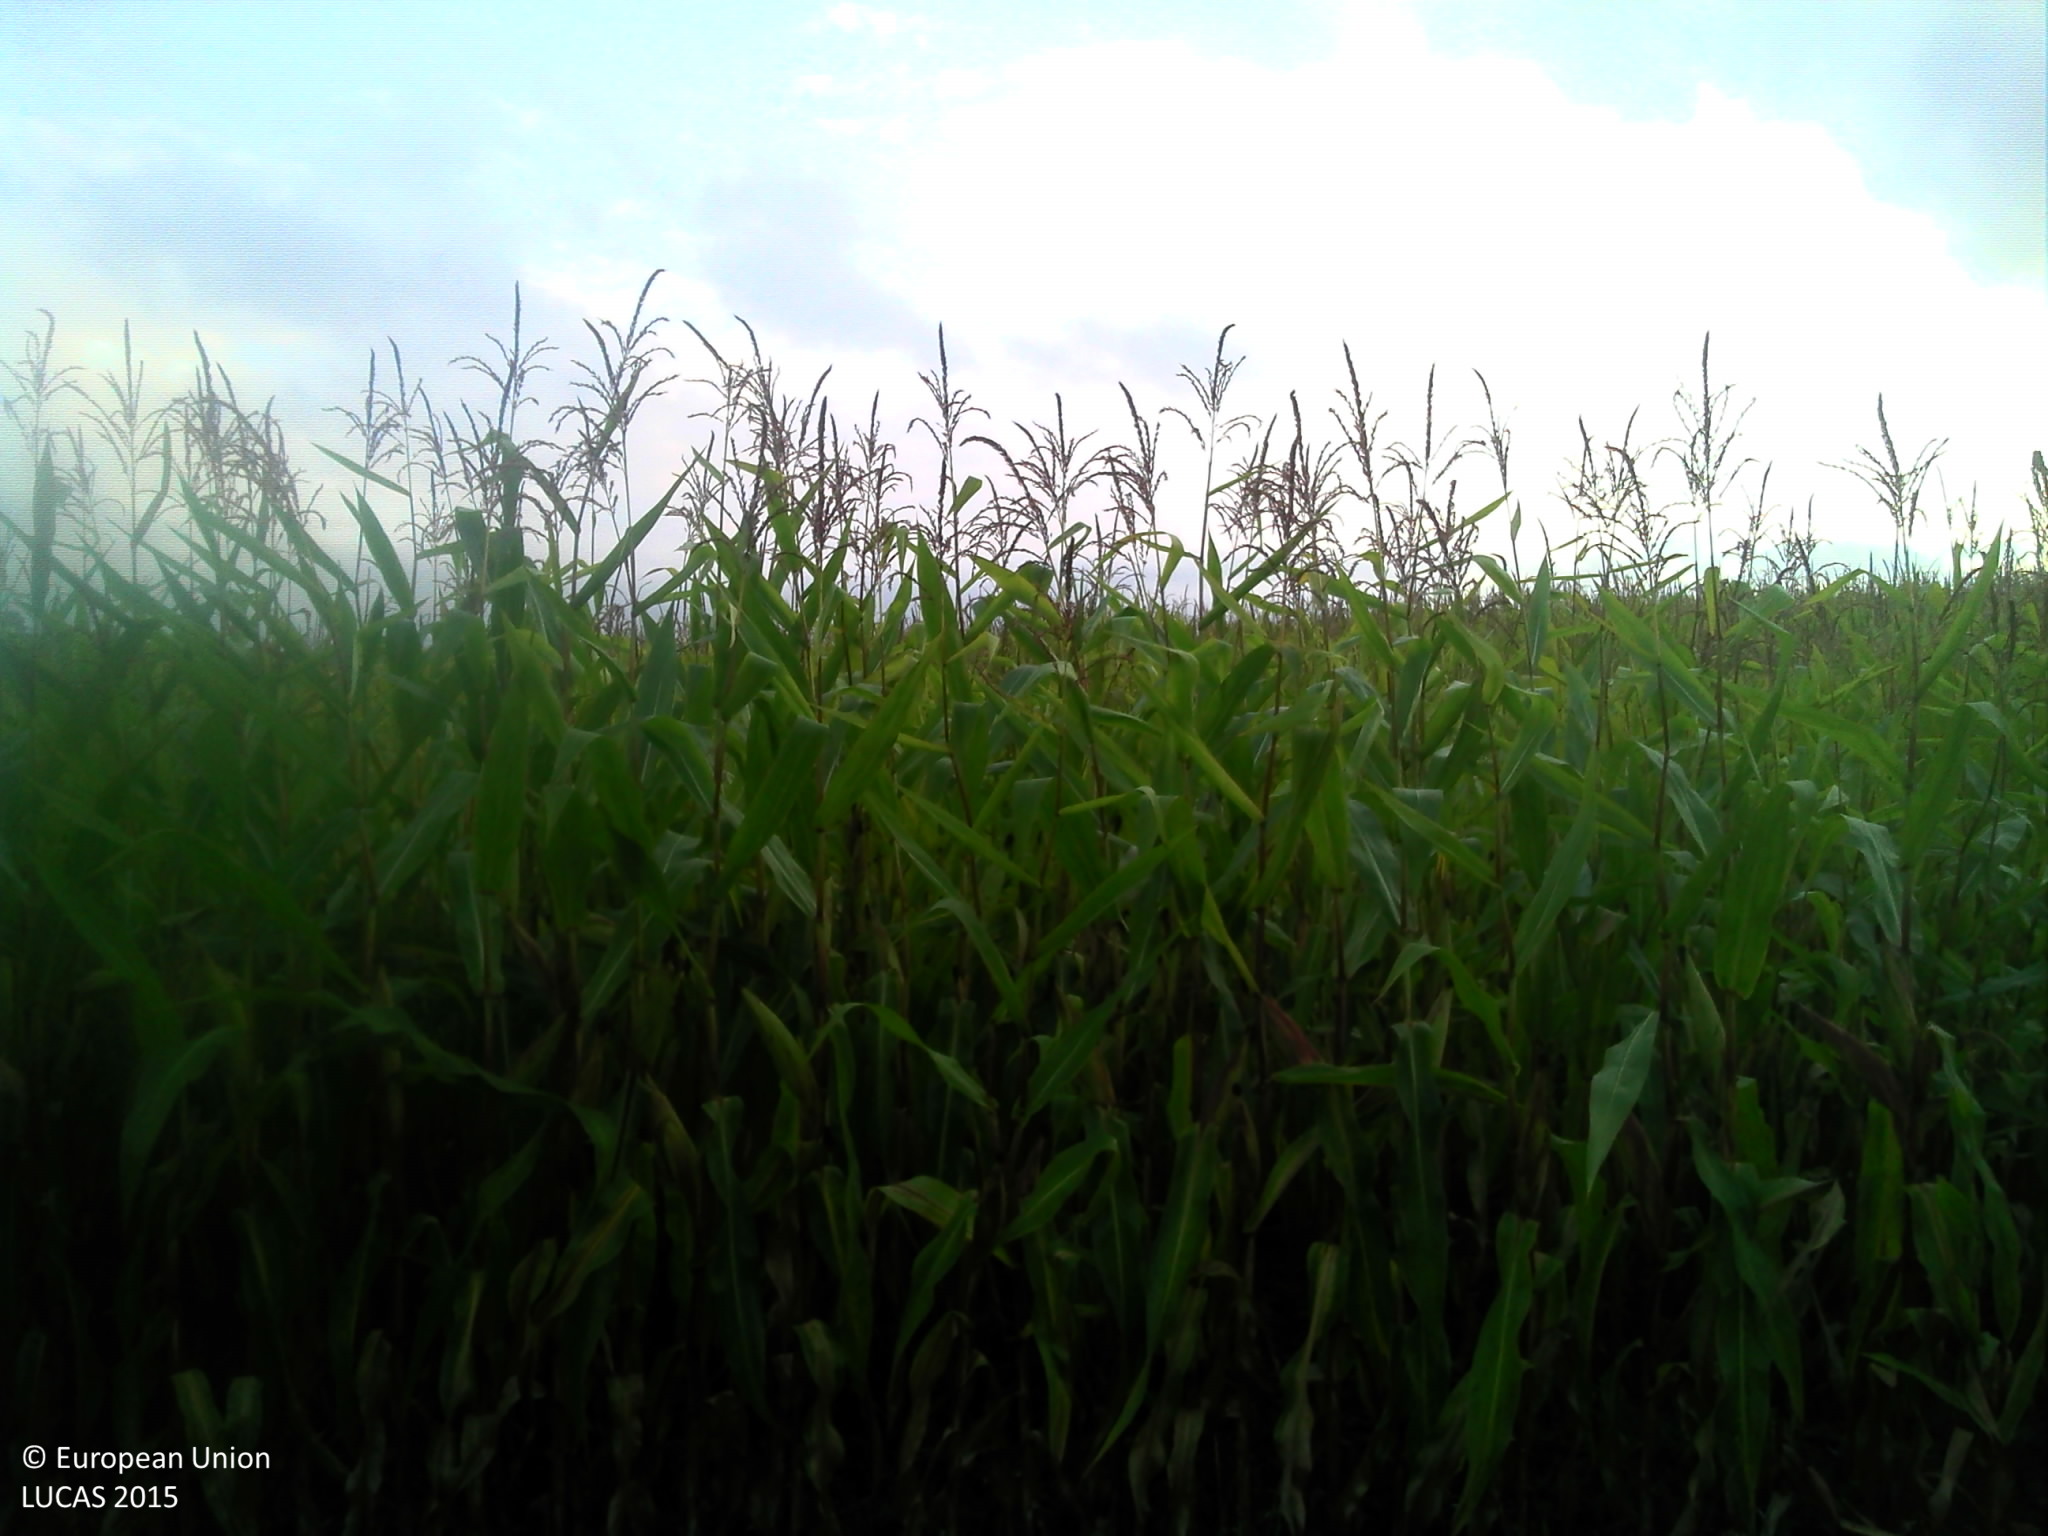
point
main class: Cropland
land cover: Maize
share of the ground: > 75 %
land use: Agriculture (excluding fallow land and kitchen gardens)
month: August
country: FR
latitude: 48.4642
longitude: 0.4948
